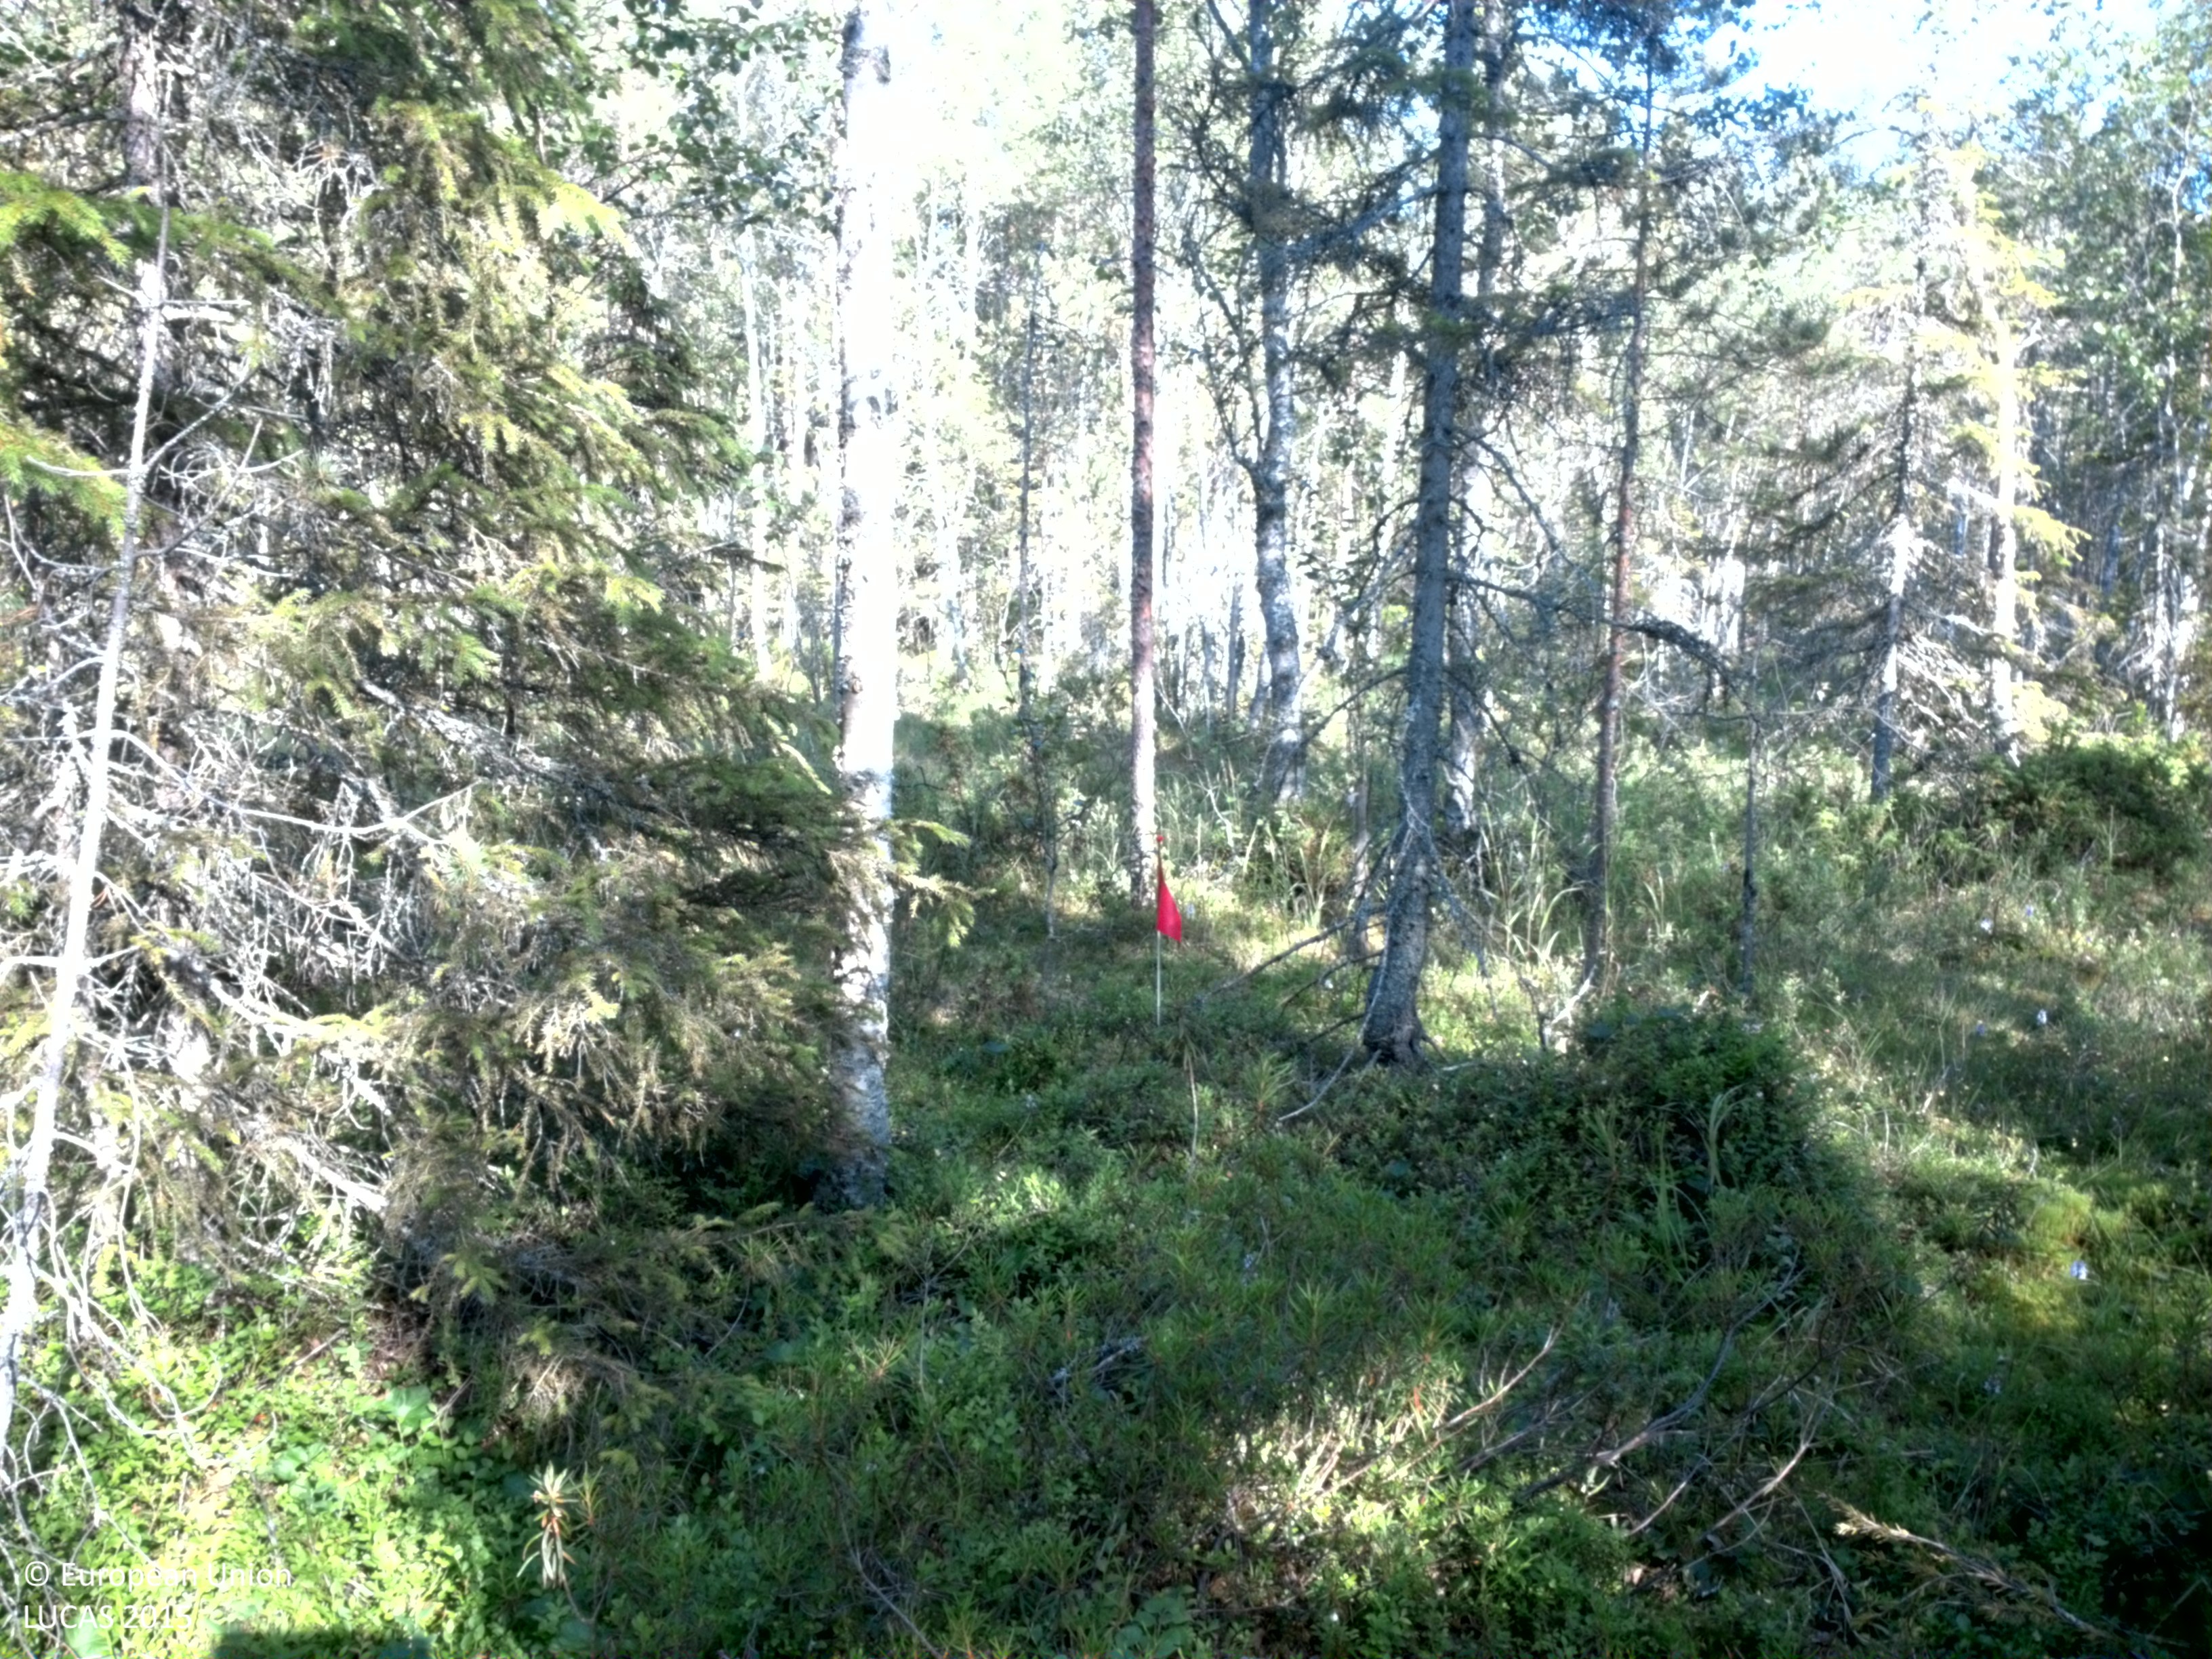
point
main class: Woodland
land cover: Spruce dominated mixed woodland
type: boreal forest
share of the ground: 50 - 75 %
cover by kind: coniferous forest trees 45 %, shrubs 30 %, broadleaved forest trees 15 %, lichens and mosses 10 %
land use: Forestry
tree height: > 5 m
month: July
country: SE
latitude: 64.2750
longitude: 21.1972
